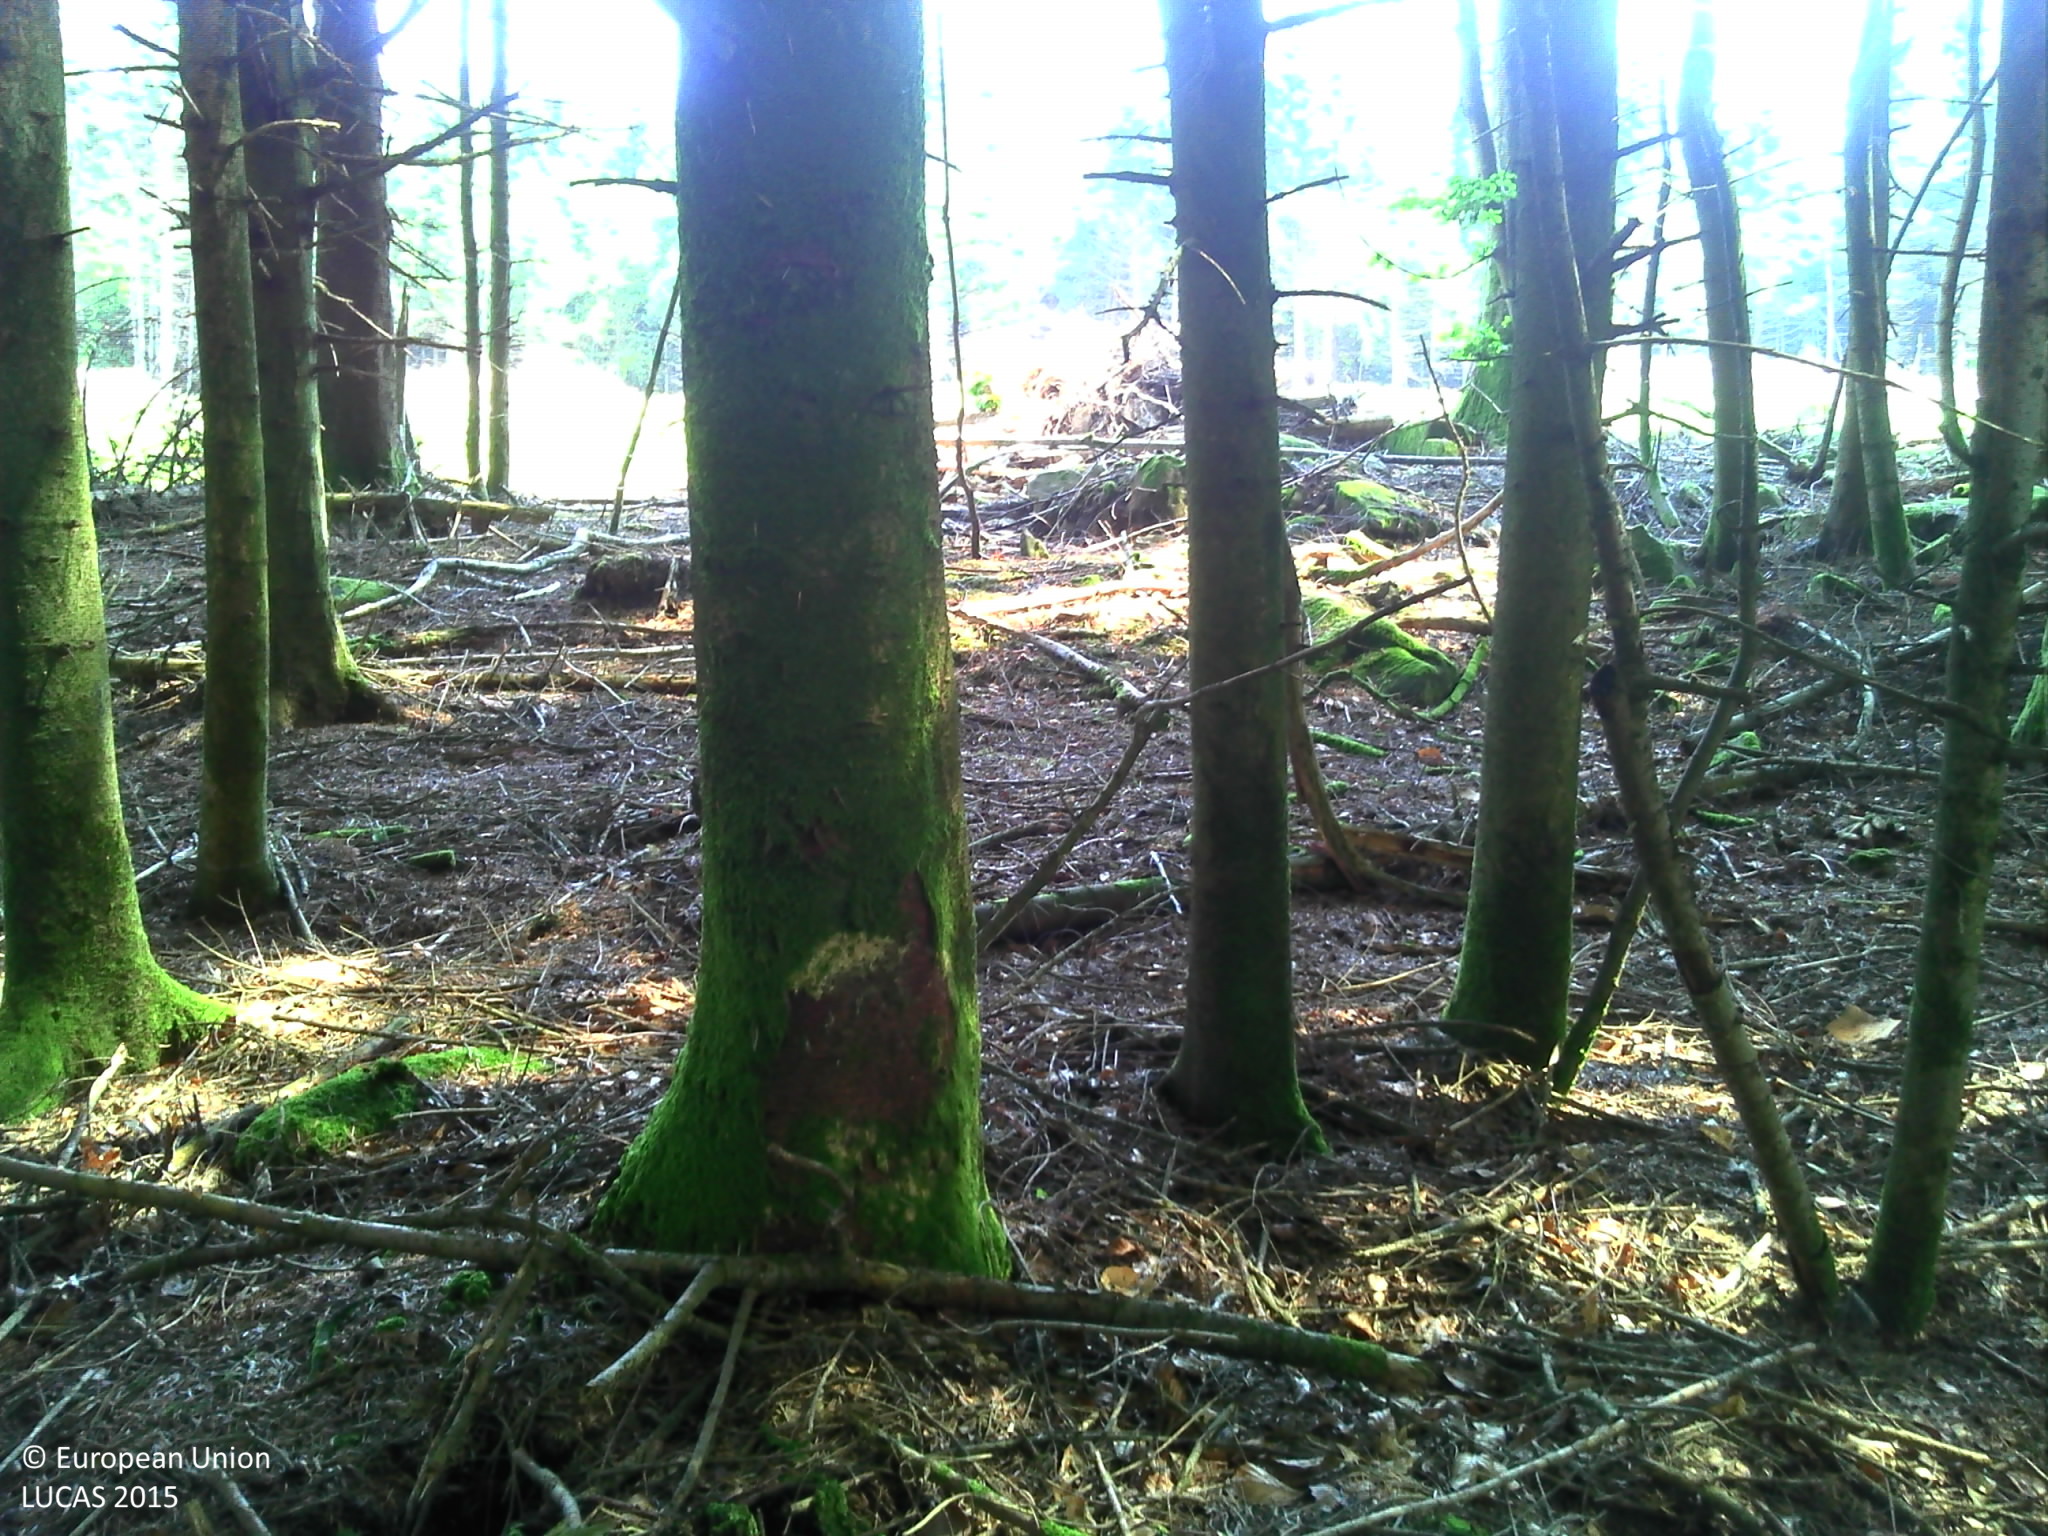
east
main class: Woodland
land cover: Spruce dominated coniferous woodland
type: hemiboreal forest and nemoral coniferous forest and mixed broadleaved-coniferous forest
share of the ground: > 75 %
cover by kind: coniferous forest trees 80 %, herbaceous plants 10 %, lichens and mosses 10 %
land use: Forestry
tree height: > 5 m
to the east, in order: Spruce dominated coniferous woodland; Spontaneously vegetated surfaces; Spruce dominated coniferous woodland; Tracks; Spruce dominated coniferous woodland; Spontaneously vegetated surfaces
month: August
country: FR
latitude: 46.1708
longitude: 4.4455
